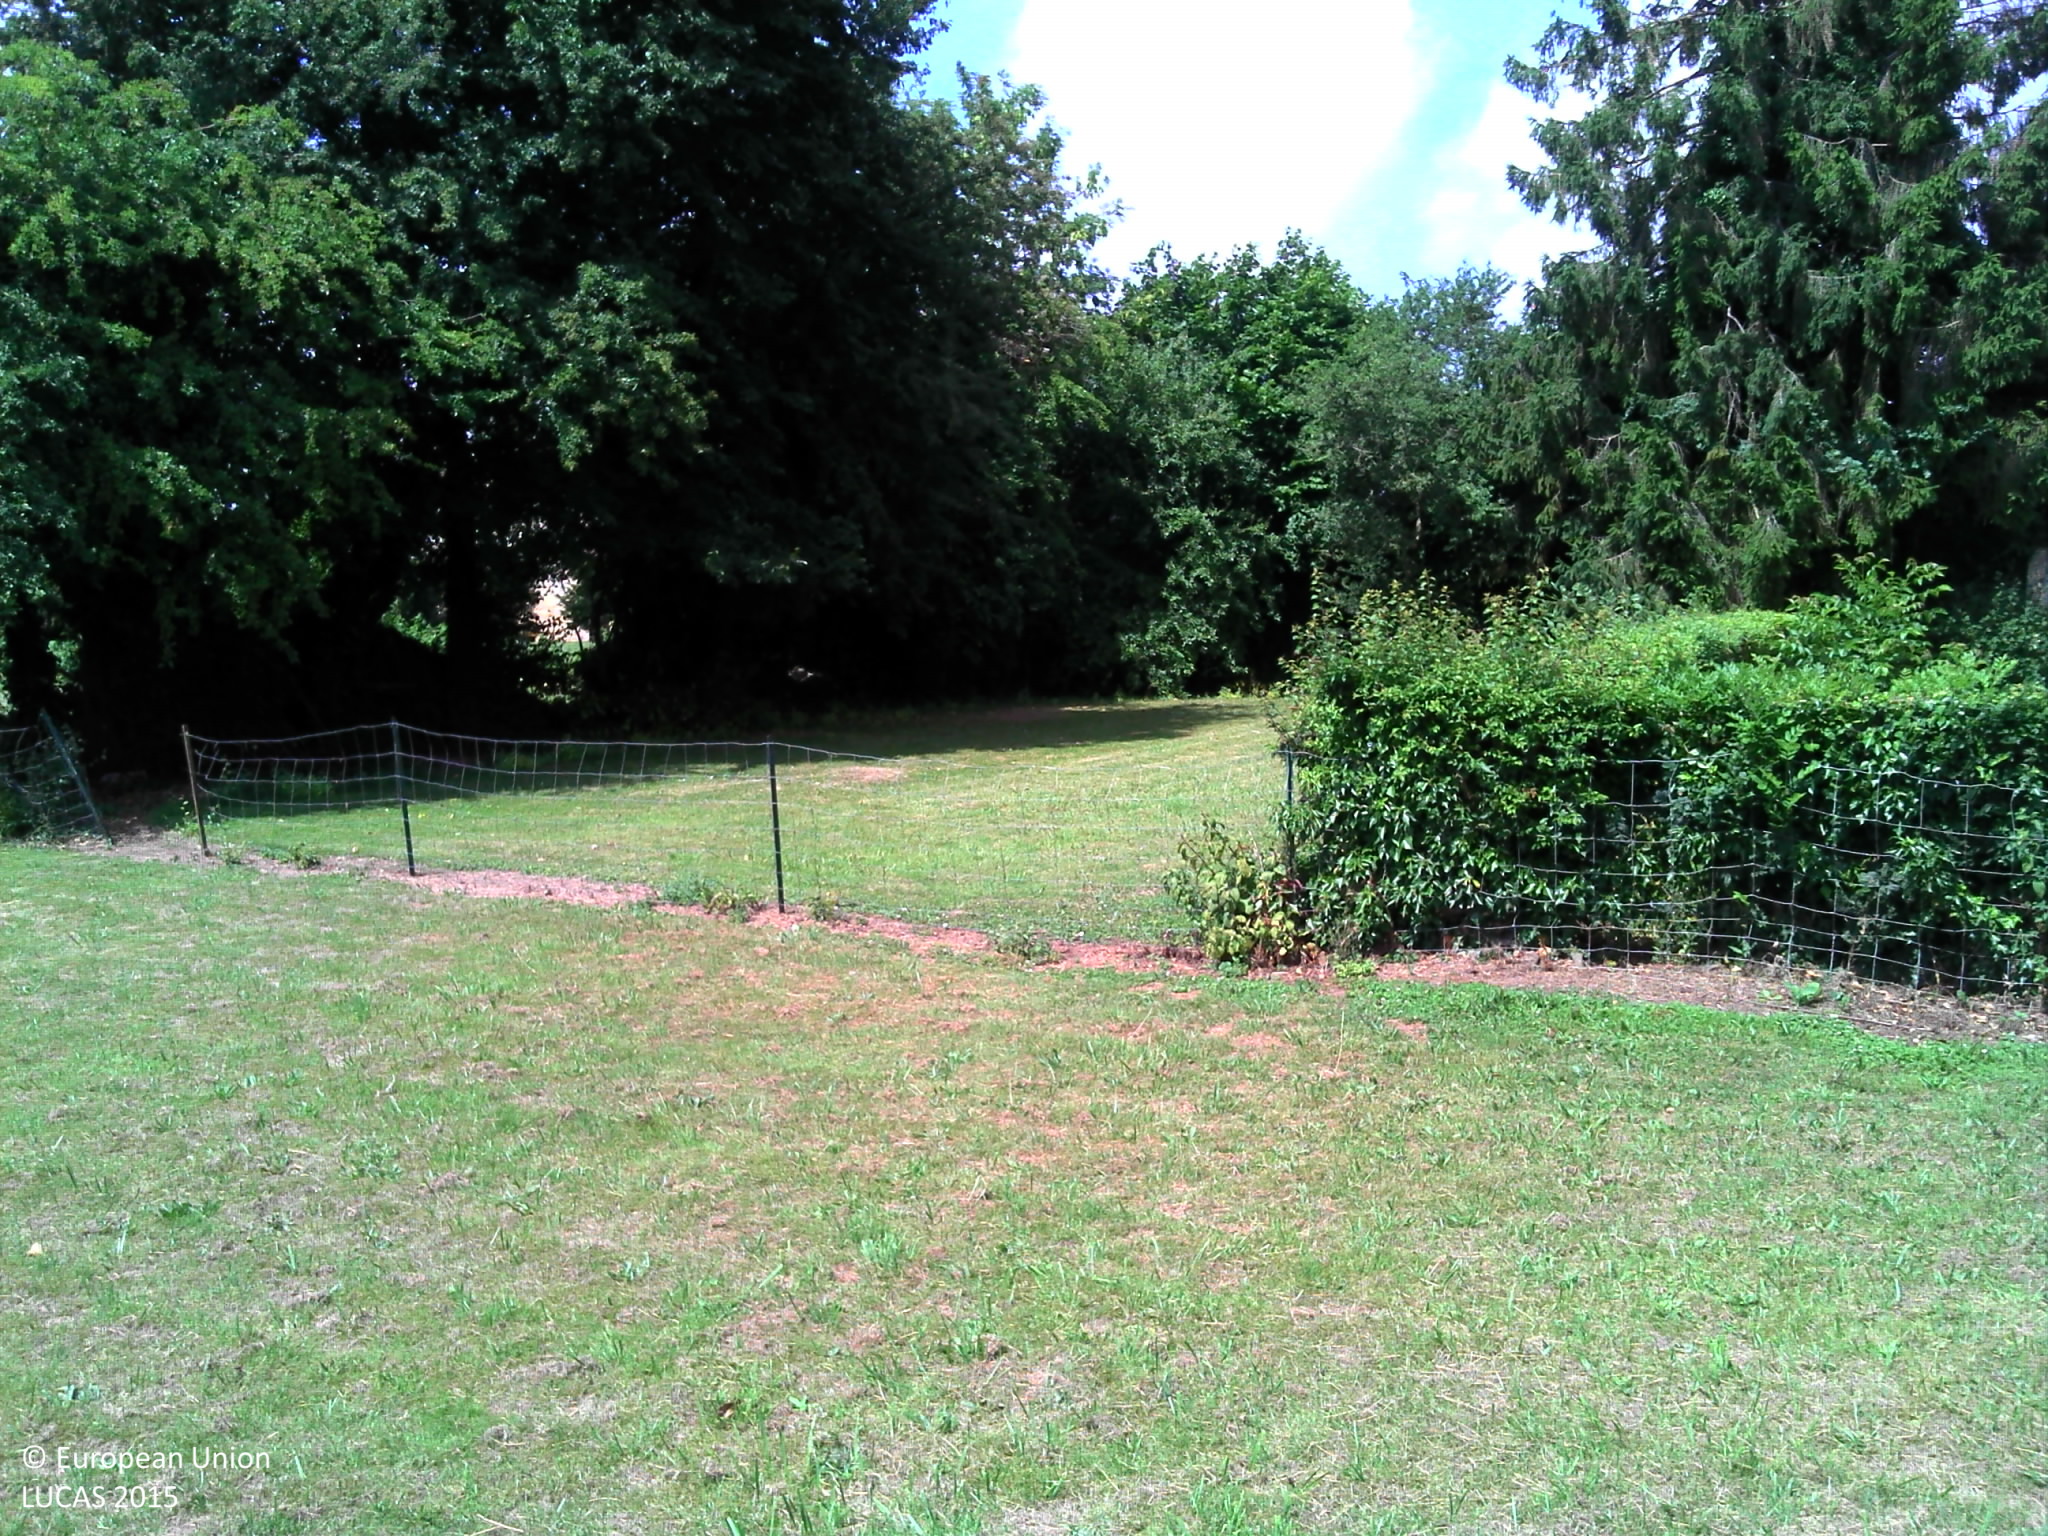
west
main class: Grassland
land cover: Grassland without tree/shrub cover
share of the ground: > 75 %
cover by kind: herbaceous plants 100 %
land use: Residential
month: July
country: FR
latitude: 48.9559
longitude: -0.2899
